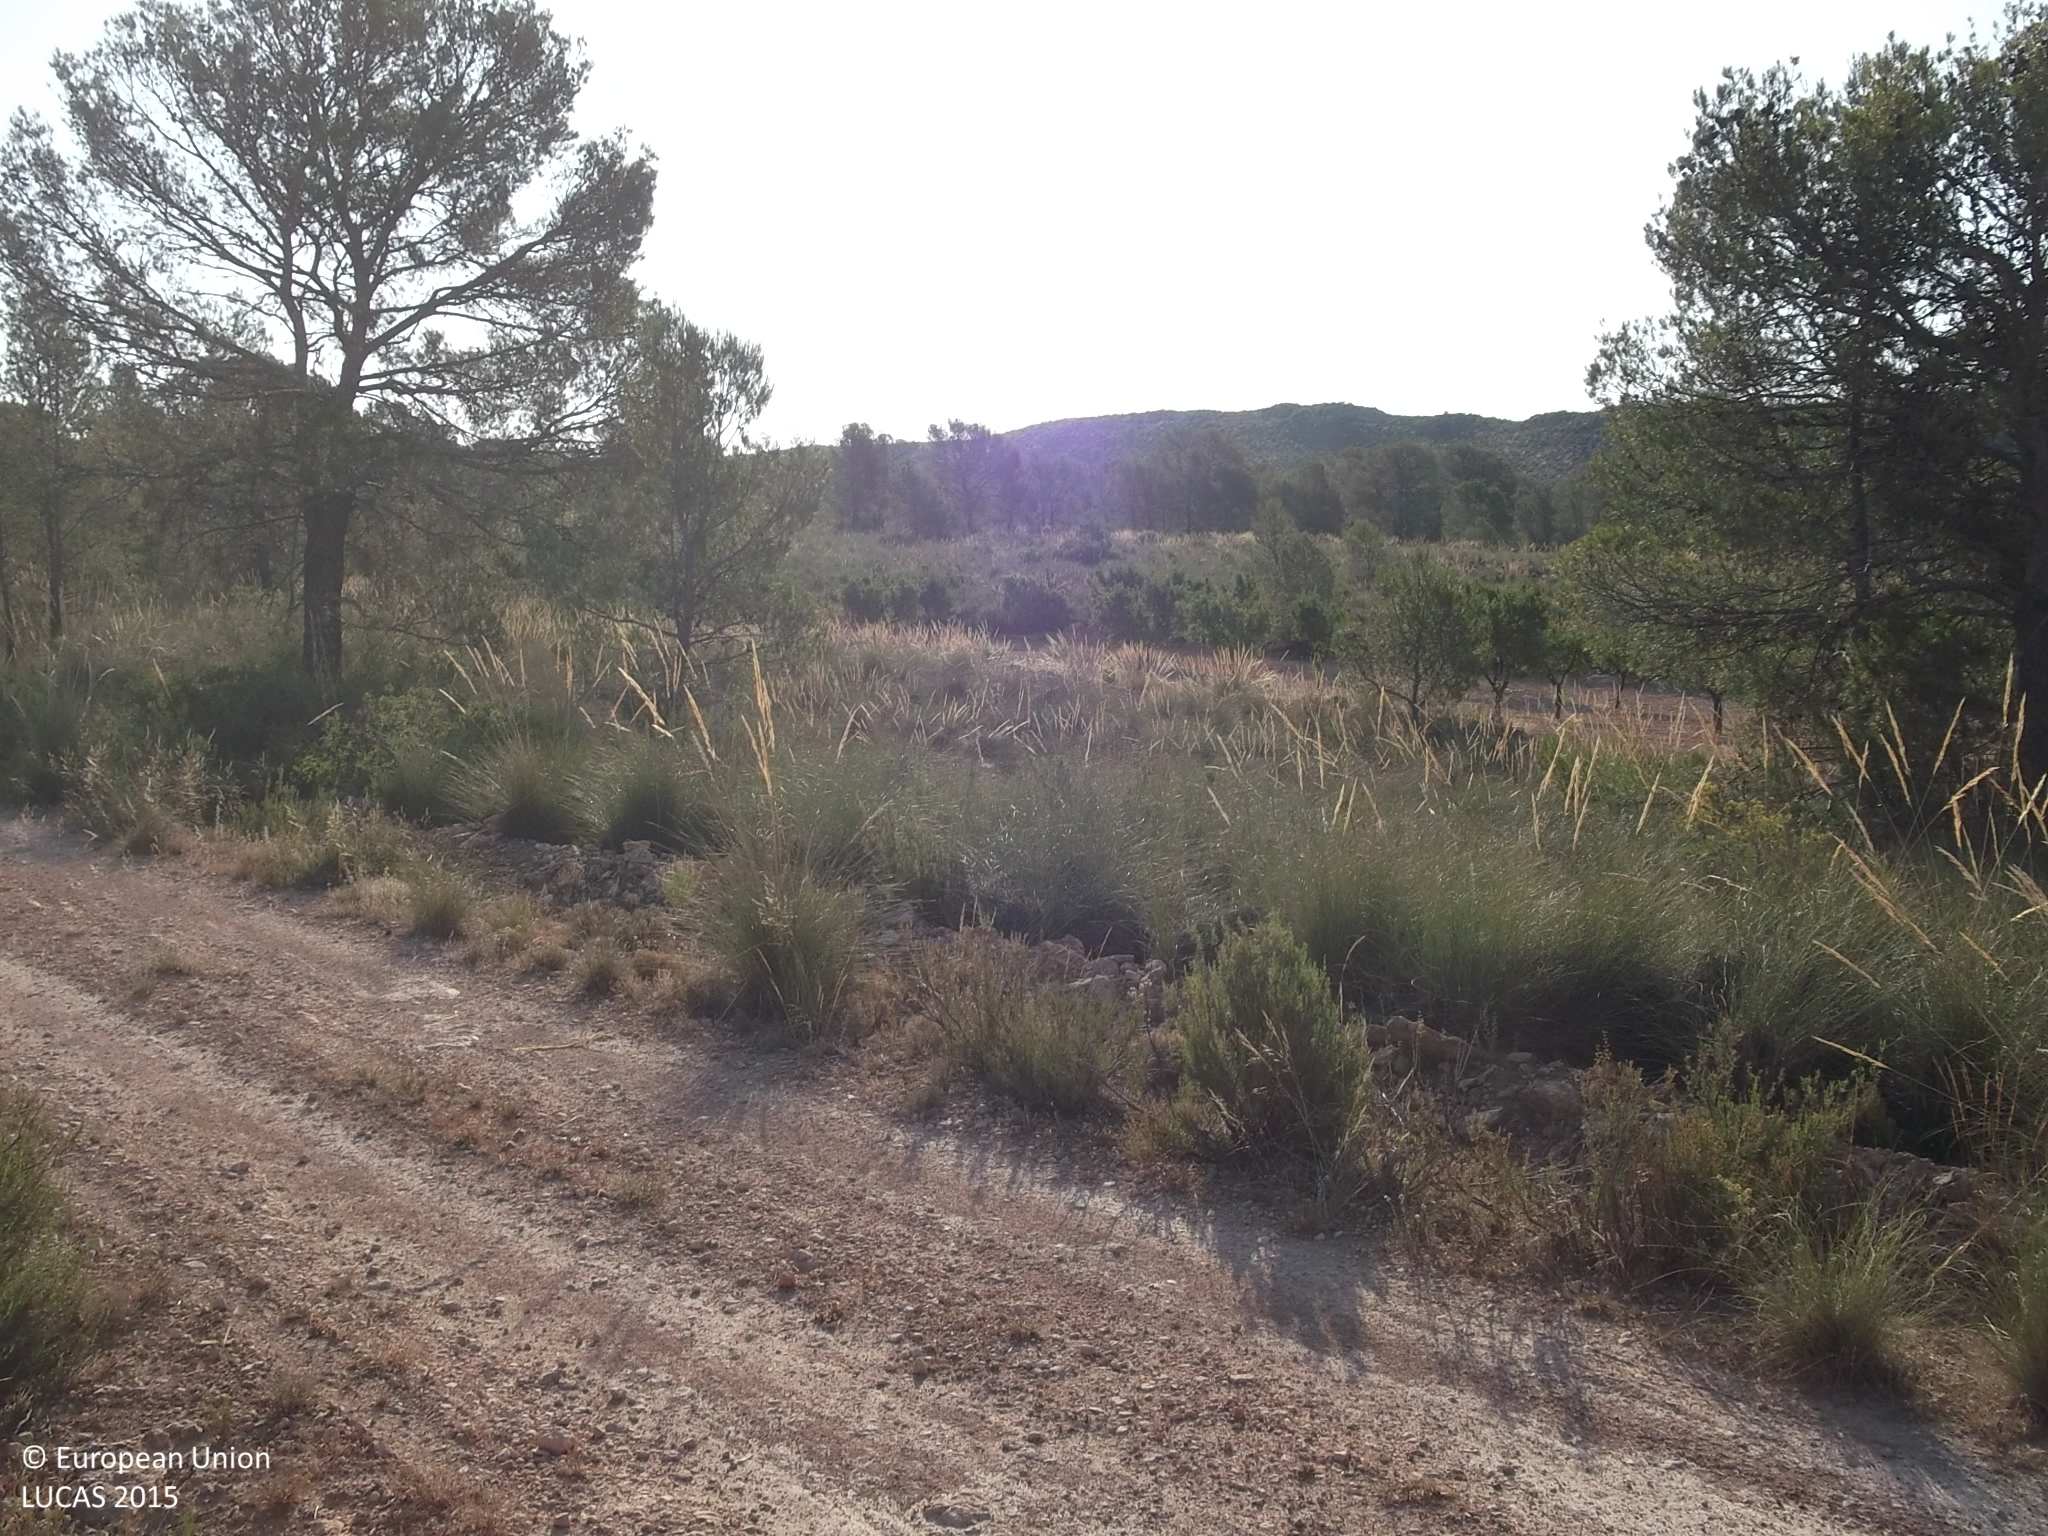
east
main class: Grassland
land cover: Grassland with sparse tree/shrub cover
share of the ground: 25 - 50 %
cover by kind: herbaceous plants 45 %, consolidated bare surface 40 %, shrubs 10 %, coniferous forest trees 5 %
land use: Abandoned areas
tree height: > 5 m
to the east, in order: Tracks; Grassland with sparse tree/shrub cover; Pine dominated coniferous woodland; Nuts trees; Shrubland without tree cover; Pine dominated coniferous woodland; Nuts trees
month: June
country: ES
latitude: 38.3458
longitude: -1.3512
